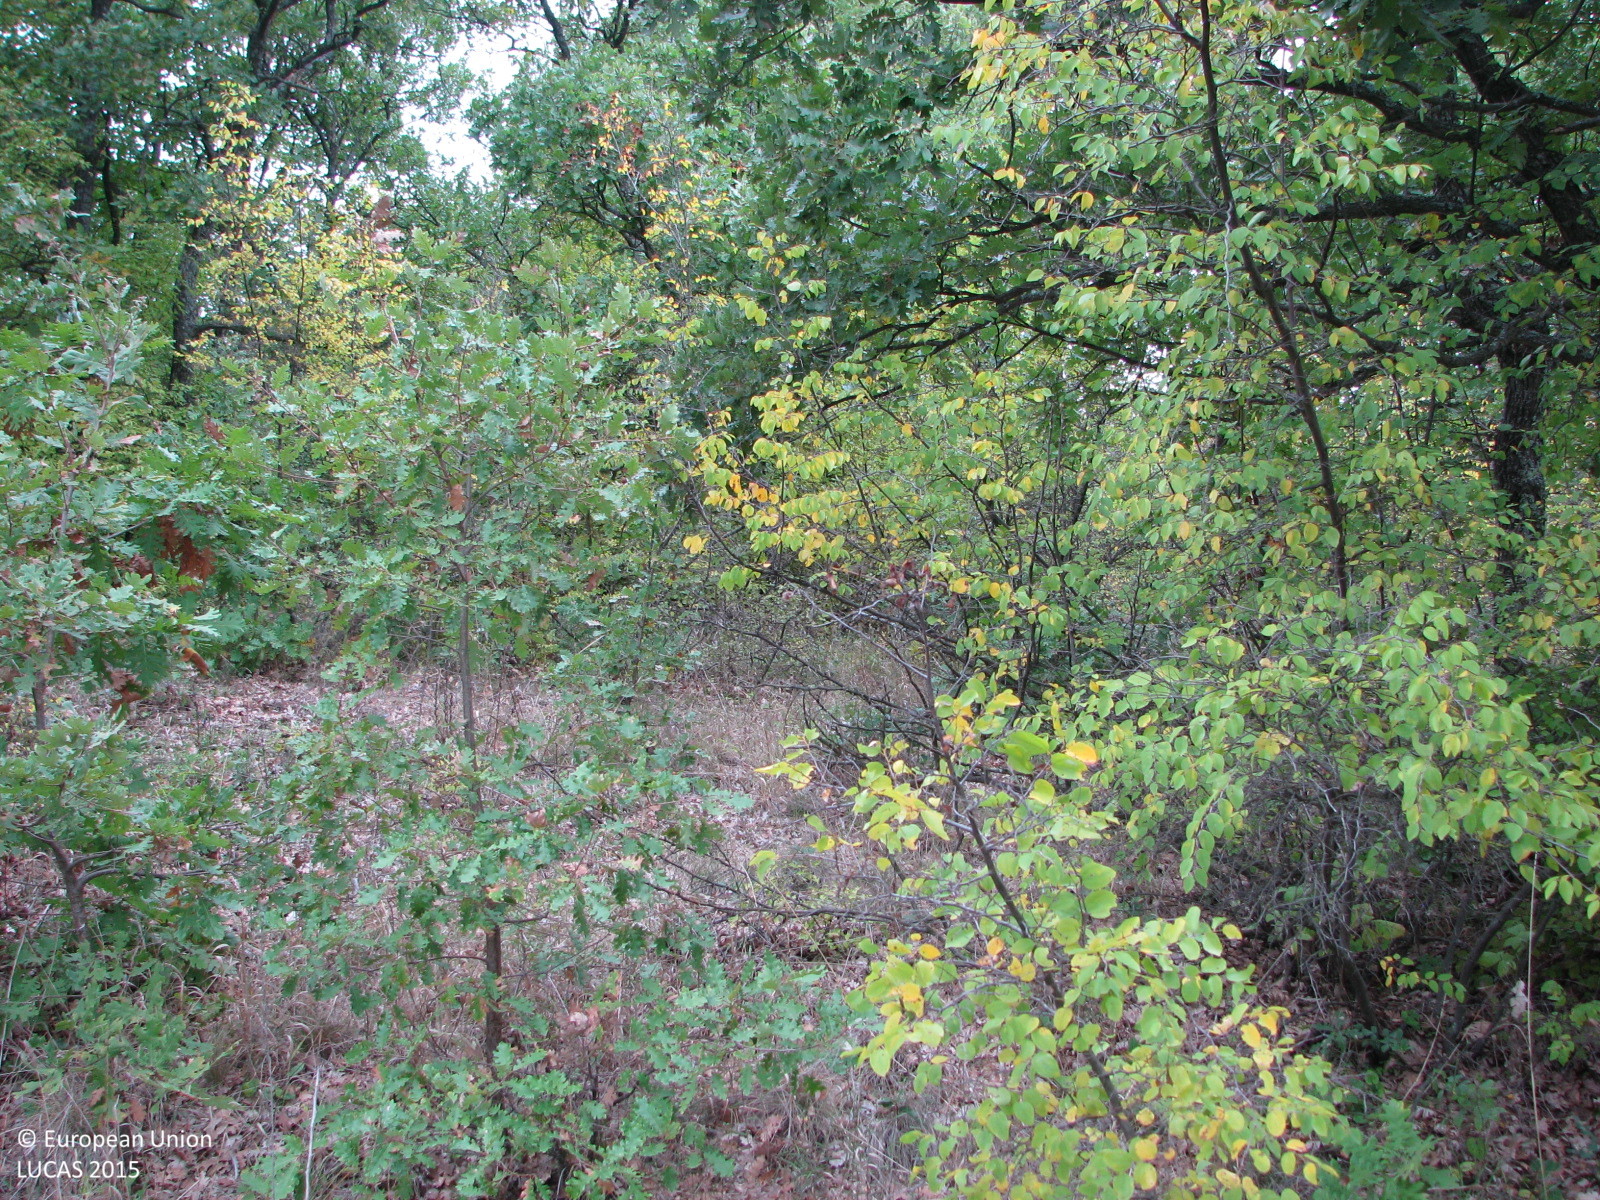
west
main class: Woodland
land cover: Broadleaved woodland
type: mesophytic deciduous forest
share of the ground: 50 - 75 %
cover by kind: broadleaved forest trees 65 %, herbaceous plants 20 %, shrubs 15 %
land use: Forestry
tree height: < 5 m
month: October
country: BG
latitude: 42.1274
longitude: 26.3297
